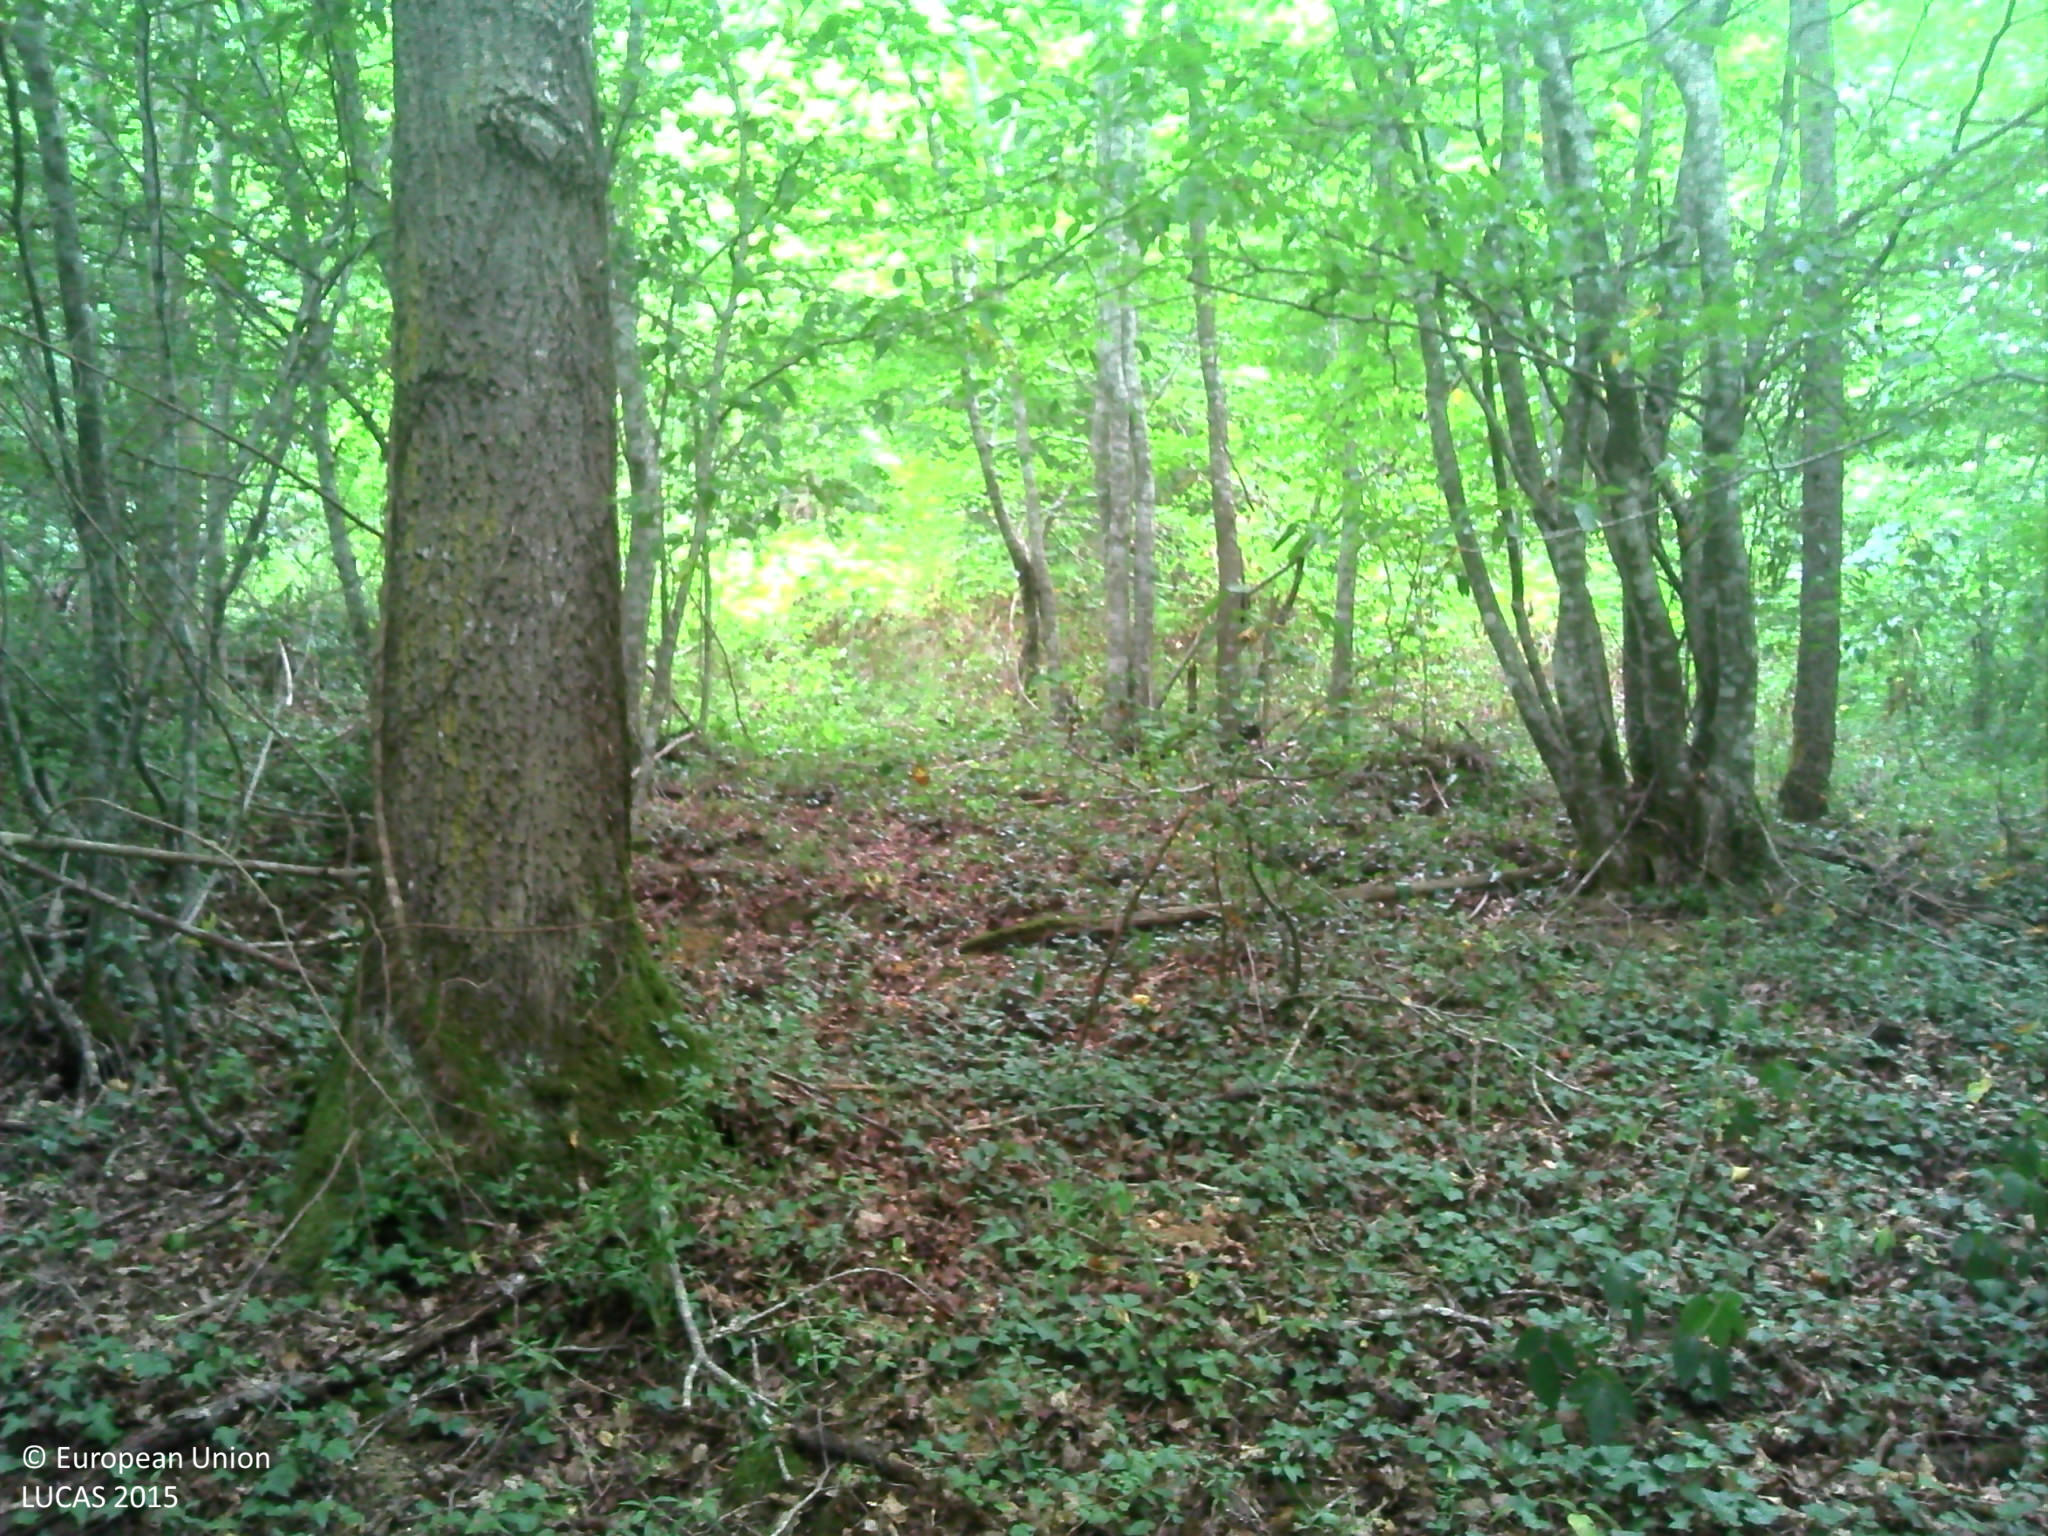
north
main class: Woodland
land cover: Broadleaved woodland
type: beech forest
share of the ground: > 75 %
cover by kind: broadleaved forest trees 100 %
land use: Forestry
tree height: > 5 m
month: July
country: FR
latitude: 43.2917
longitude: 0.8438
